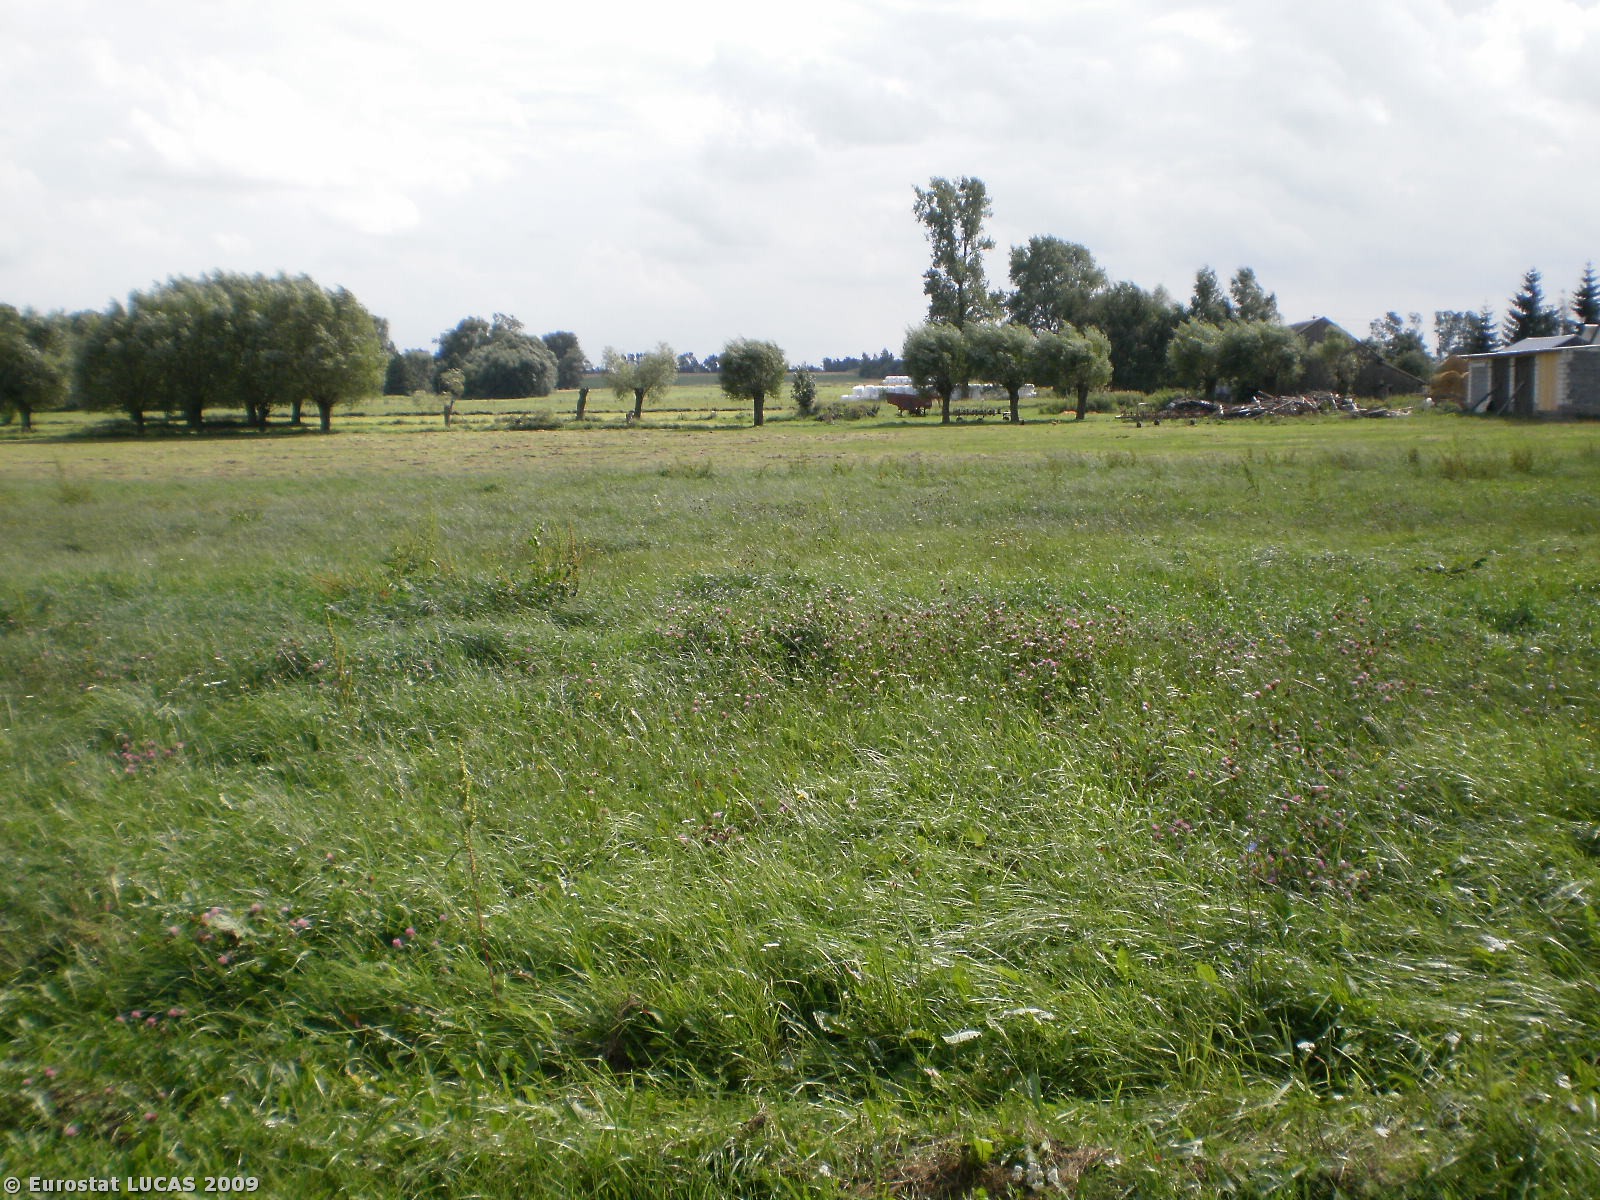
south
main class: Grassland
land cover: Grassland without tree/shrub cover
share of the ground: > 75 %
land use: Agriculture (excluding fallow land and kitchen gardens)
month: August
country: PL
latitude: 52.8282
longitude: 20.9821
